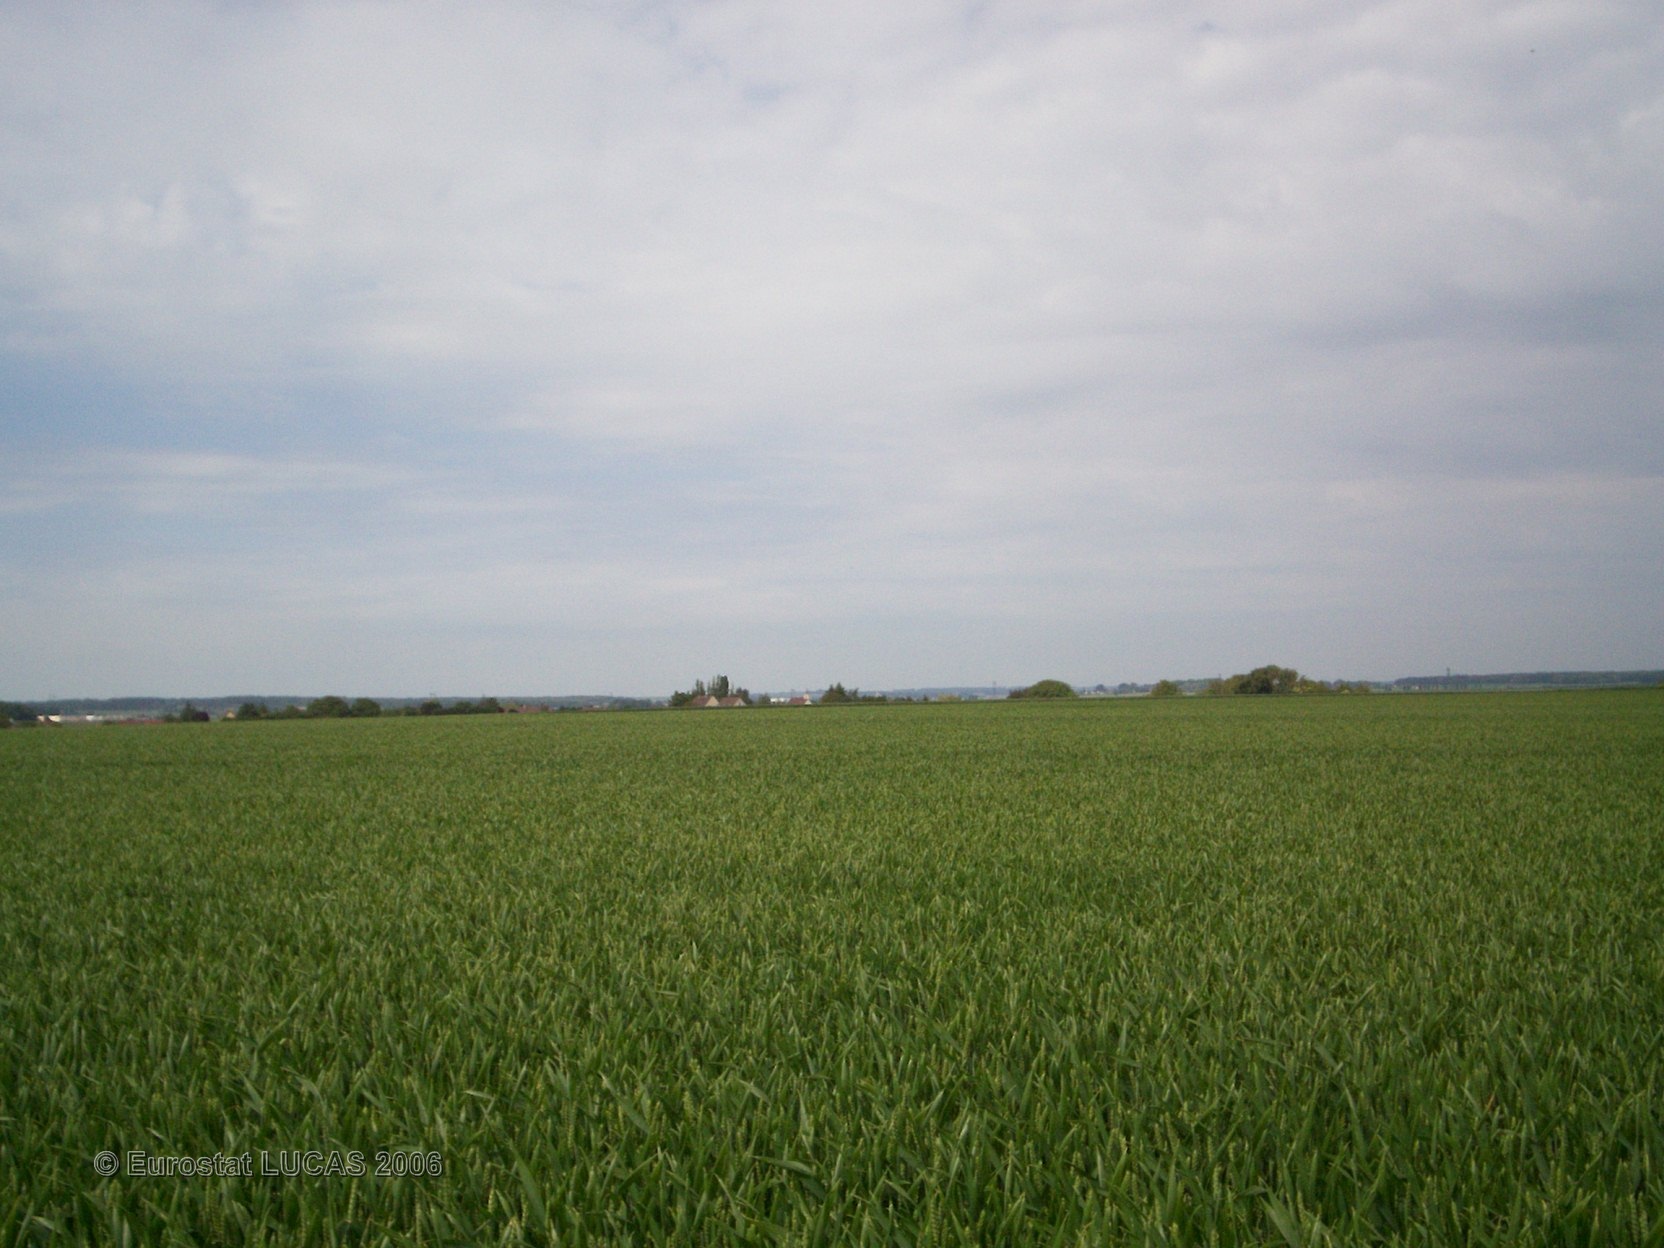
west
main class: Cropland
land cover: Common wheat
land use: Agriculture (excluding fallow land and kitchen gardens)
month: June
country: FR
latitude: 49.4476
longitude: 2.7479
